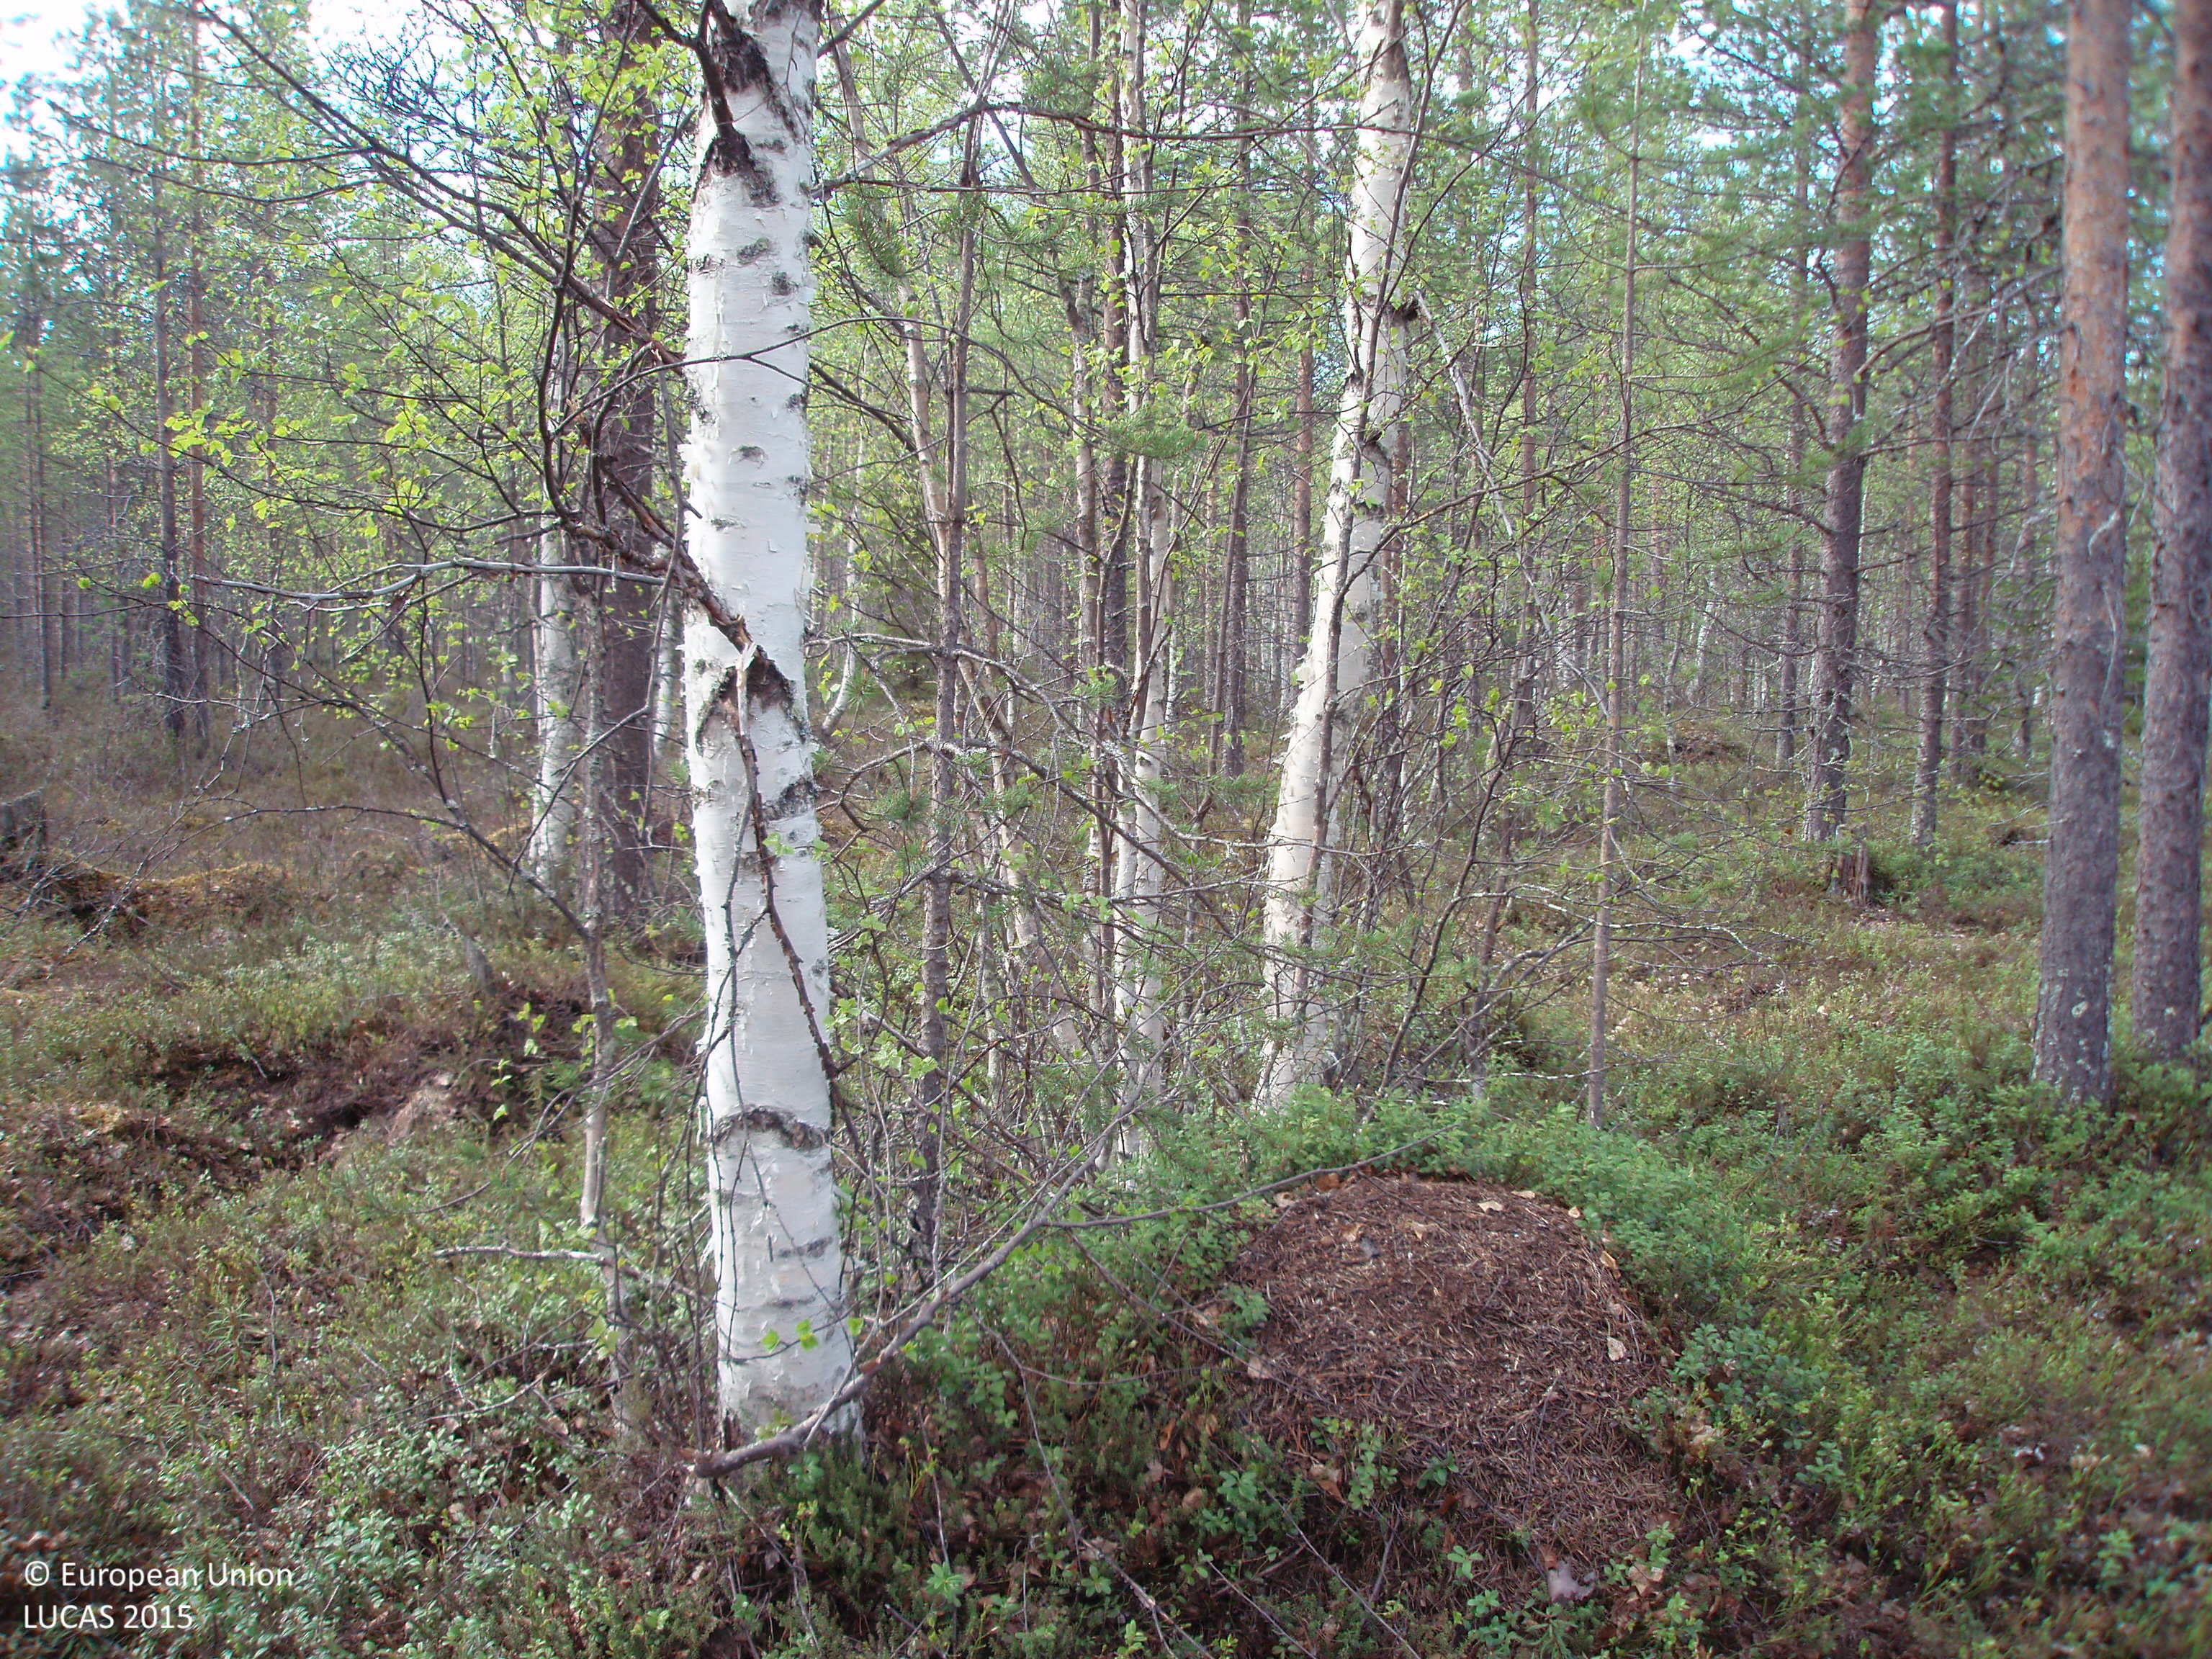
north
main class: Woodland
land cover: Pine dominated coniferous woodland
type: boreal forest
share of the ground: > 75 %
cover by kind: coniferous forest trees 70 %, broadleaved forest trees 15 %, shrubs 15 %
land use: Forestry
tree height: > 5 m
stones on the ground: < 10 %
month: June
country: FI
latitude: 66.6921
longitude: 26.7833
